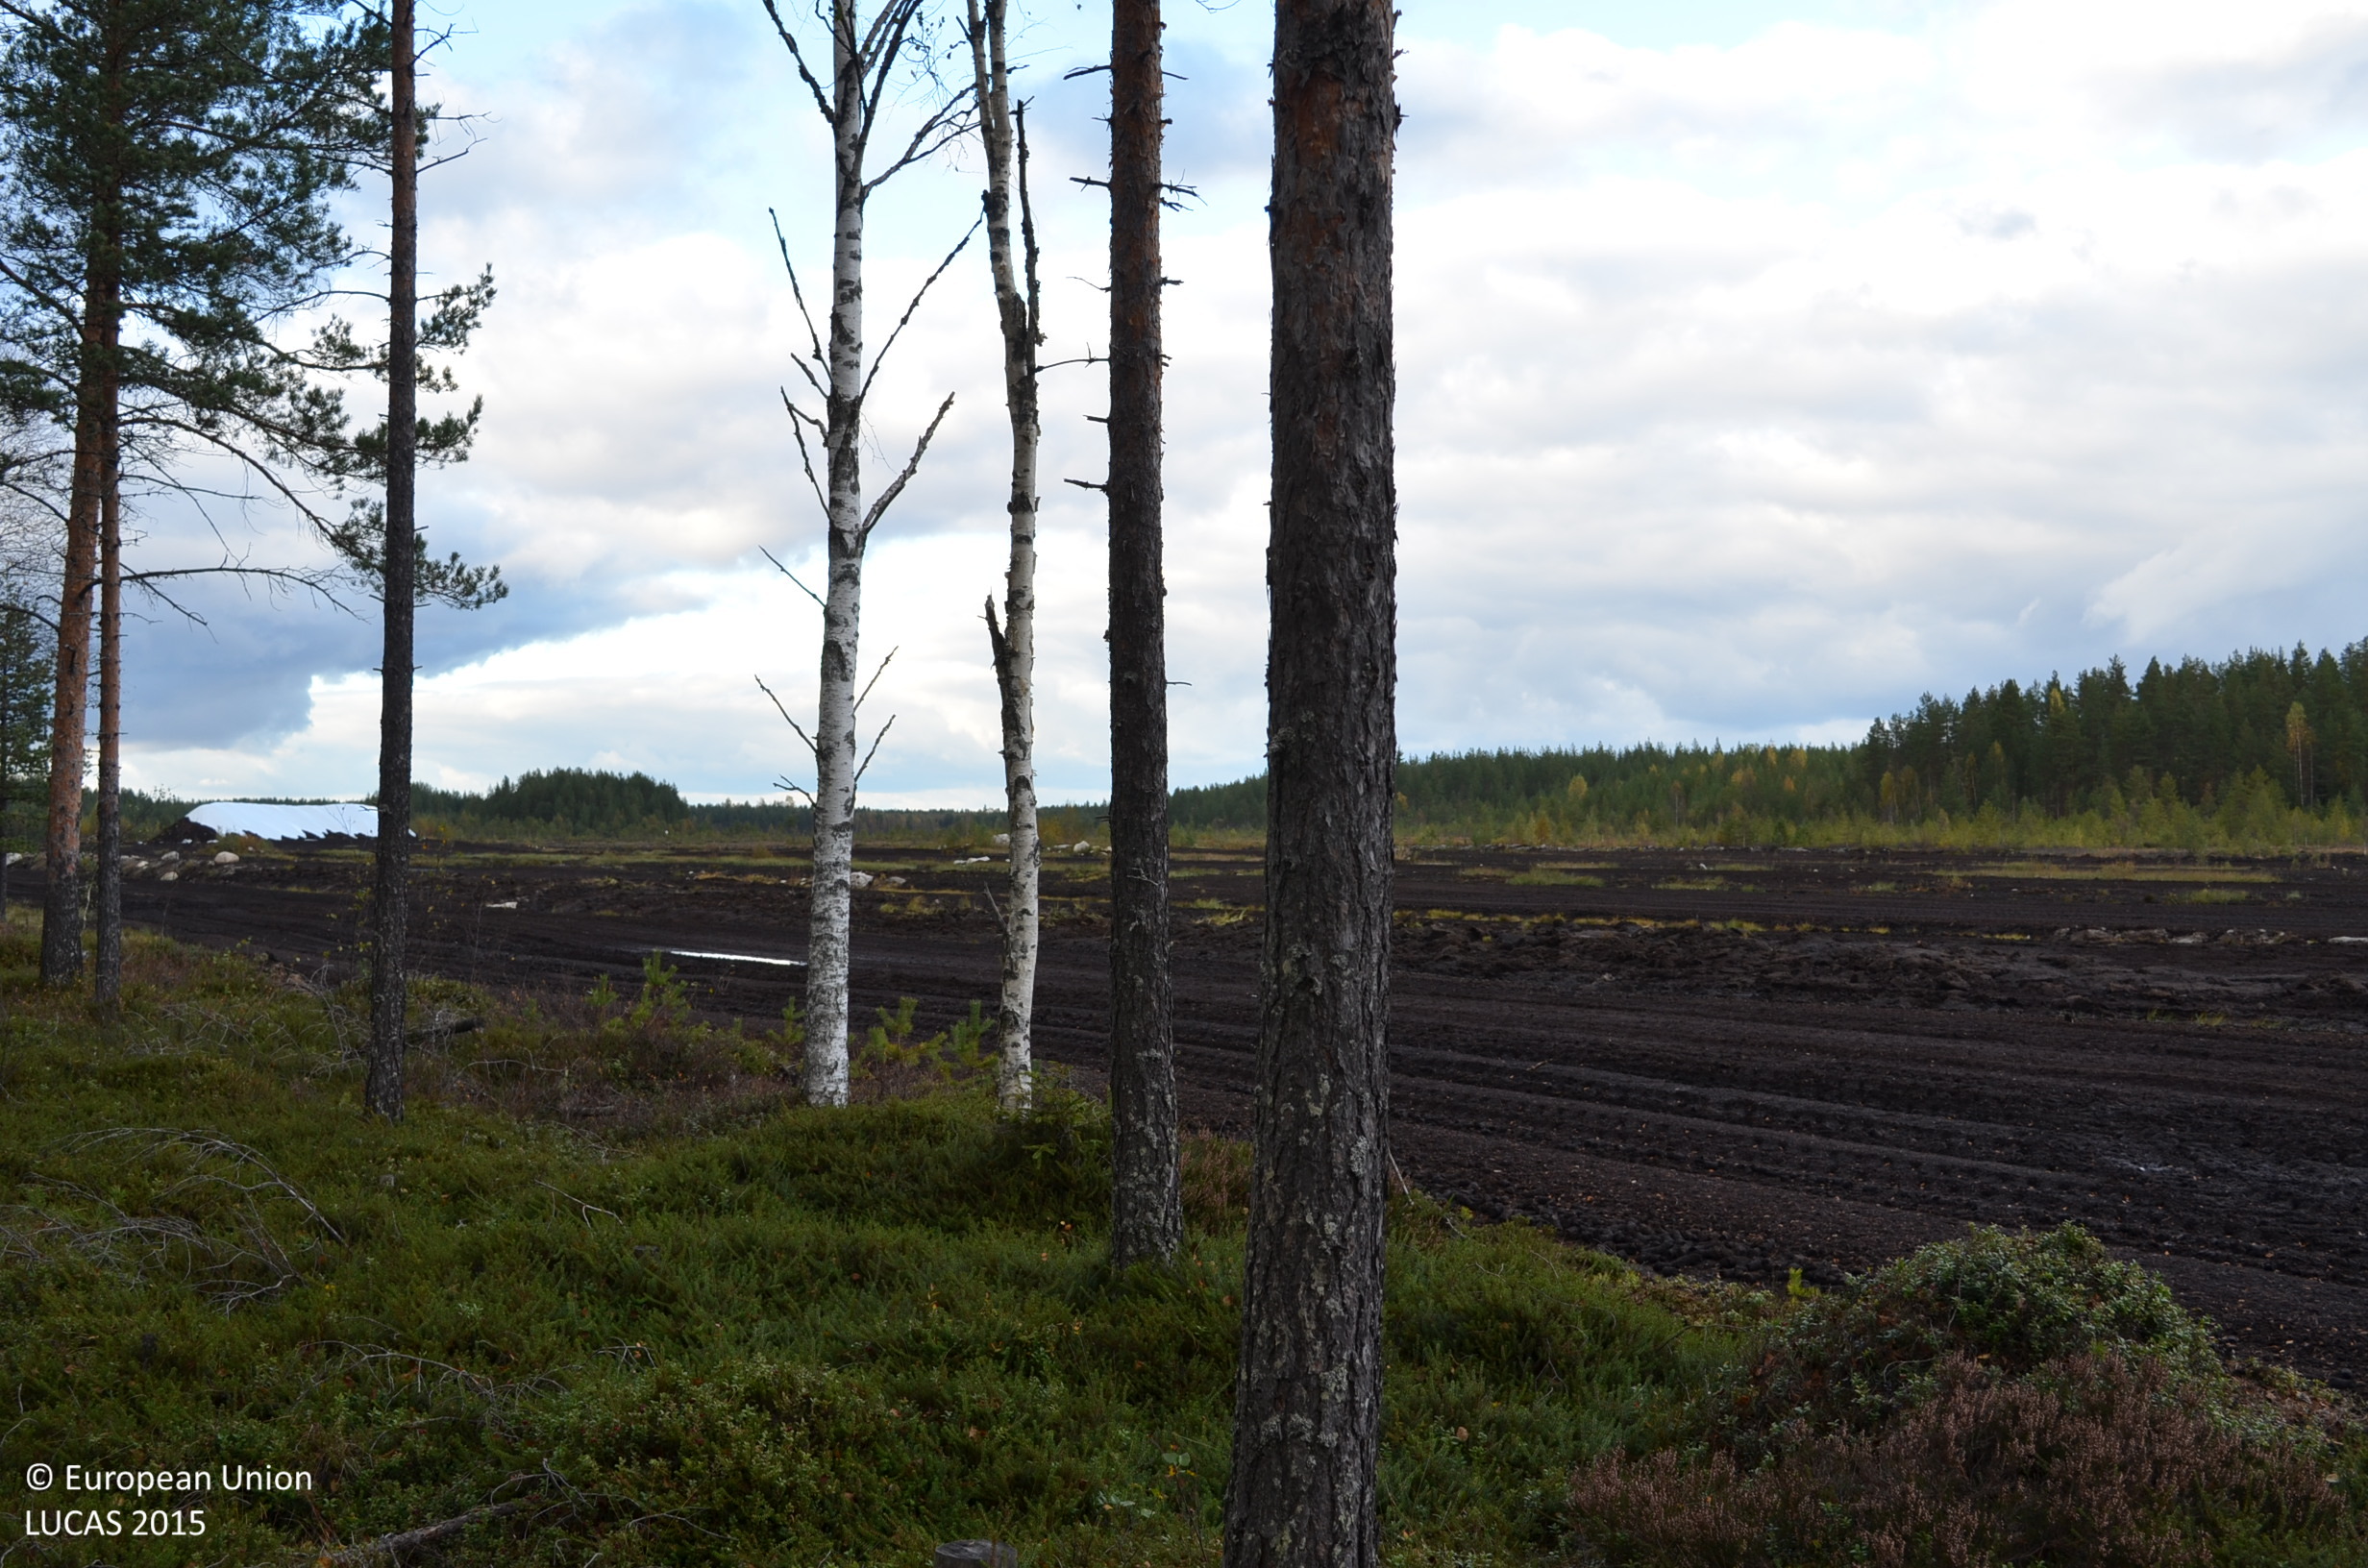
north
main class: Woodland
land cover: Pine dominated mixed woodland
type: boreal forest
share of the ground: 50 - 75 %
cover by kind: coniferous forest trees 40 %, broadleaved forest trees 30 %, shrubs 30 %
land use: Forestry
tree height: > 5 m
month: September
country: FI
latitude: 62.4906
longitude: 23.5597
